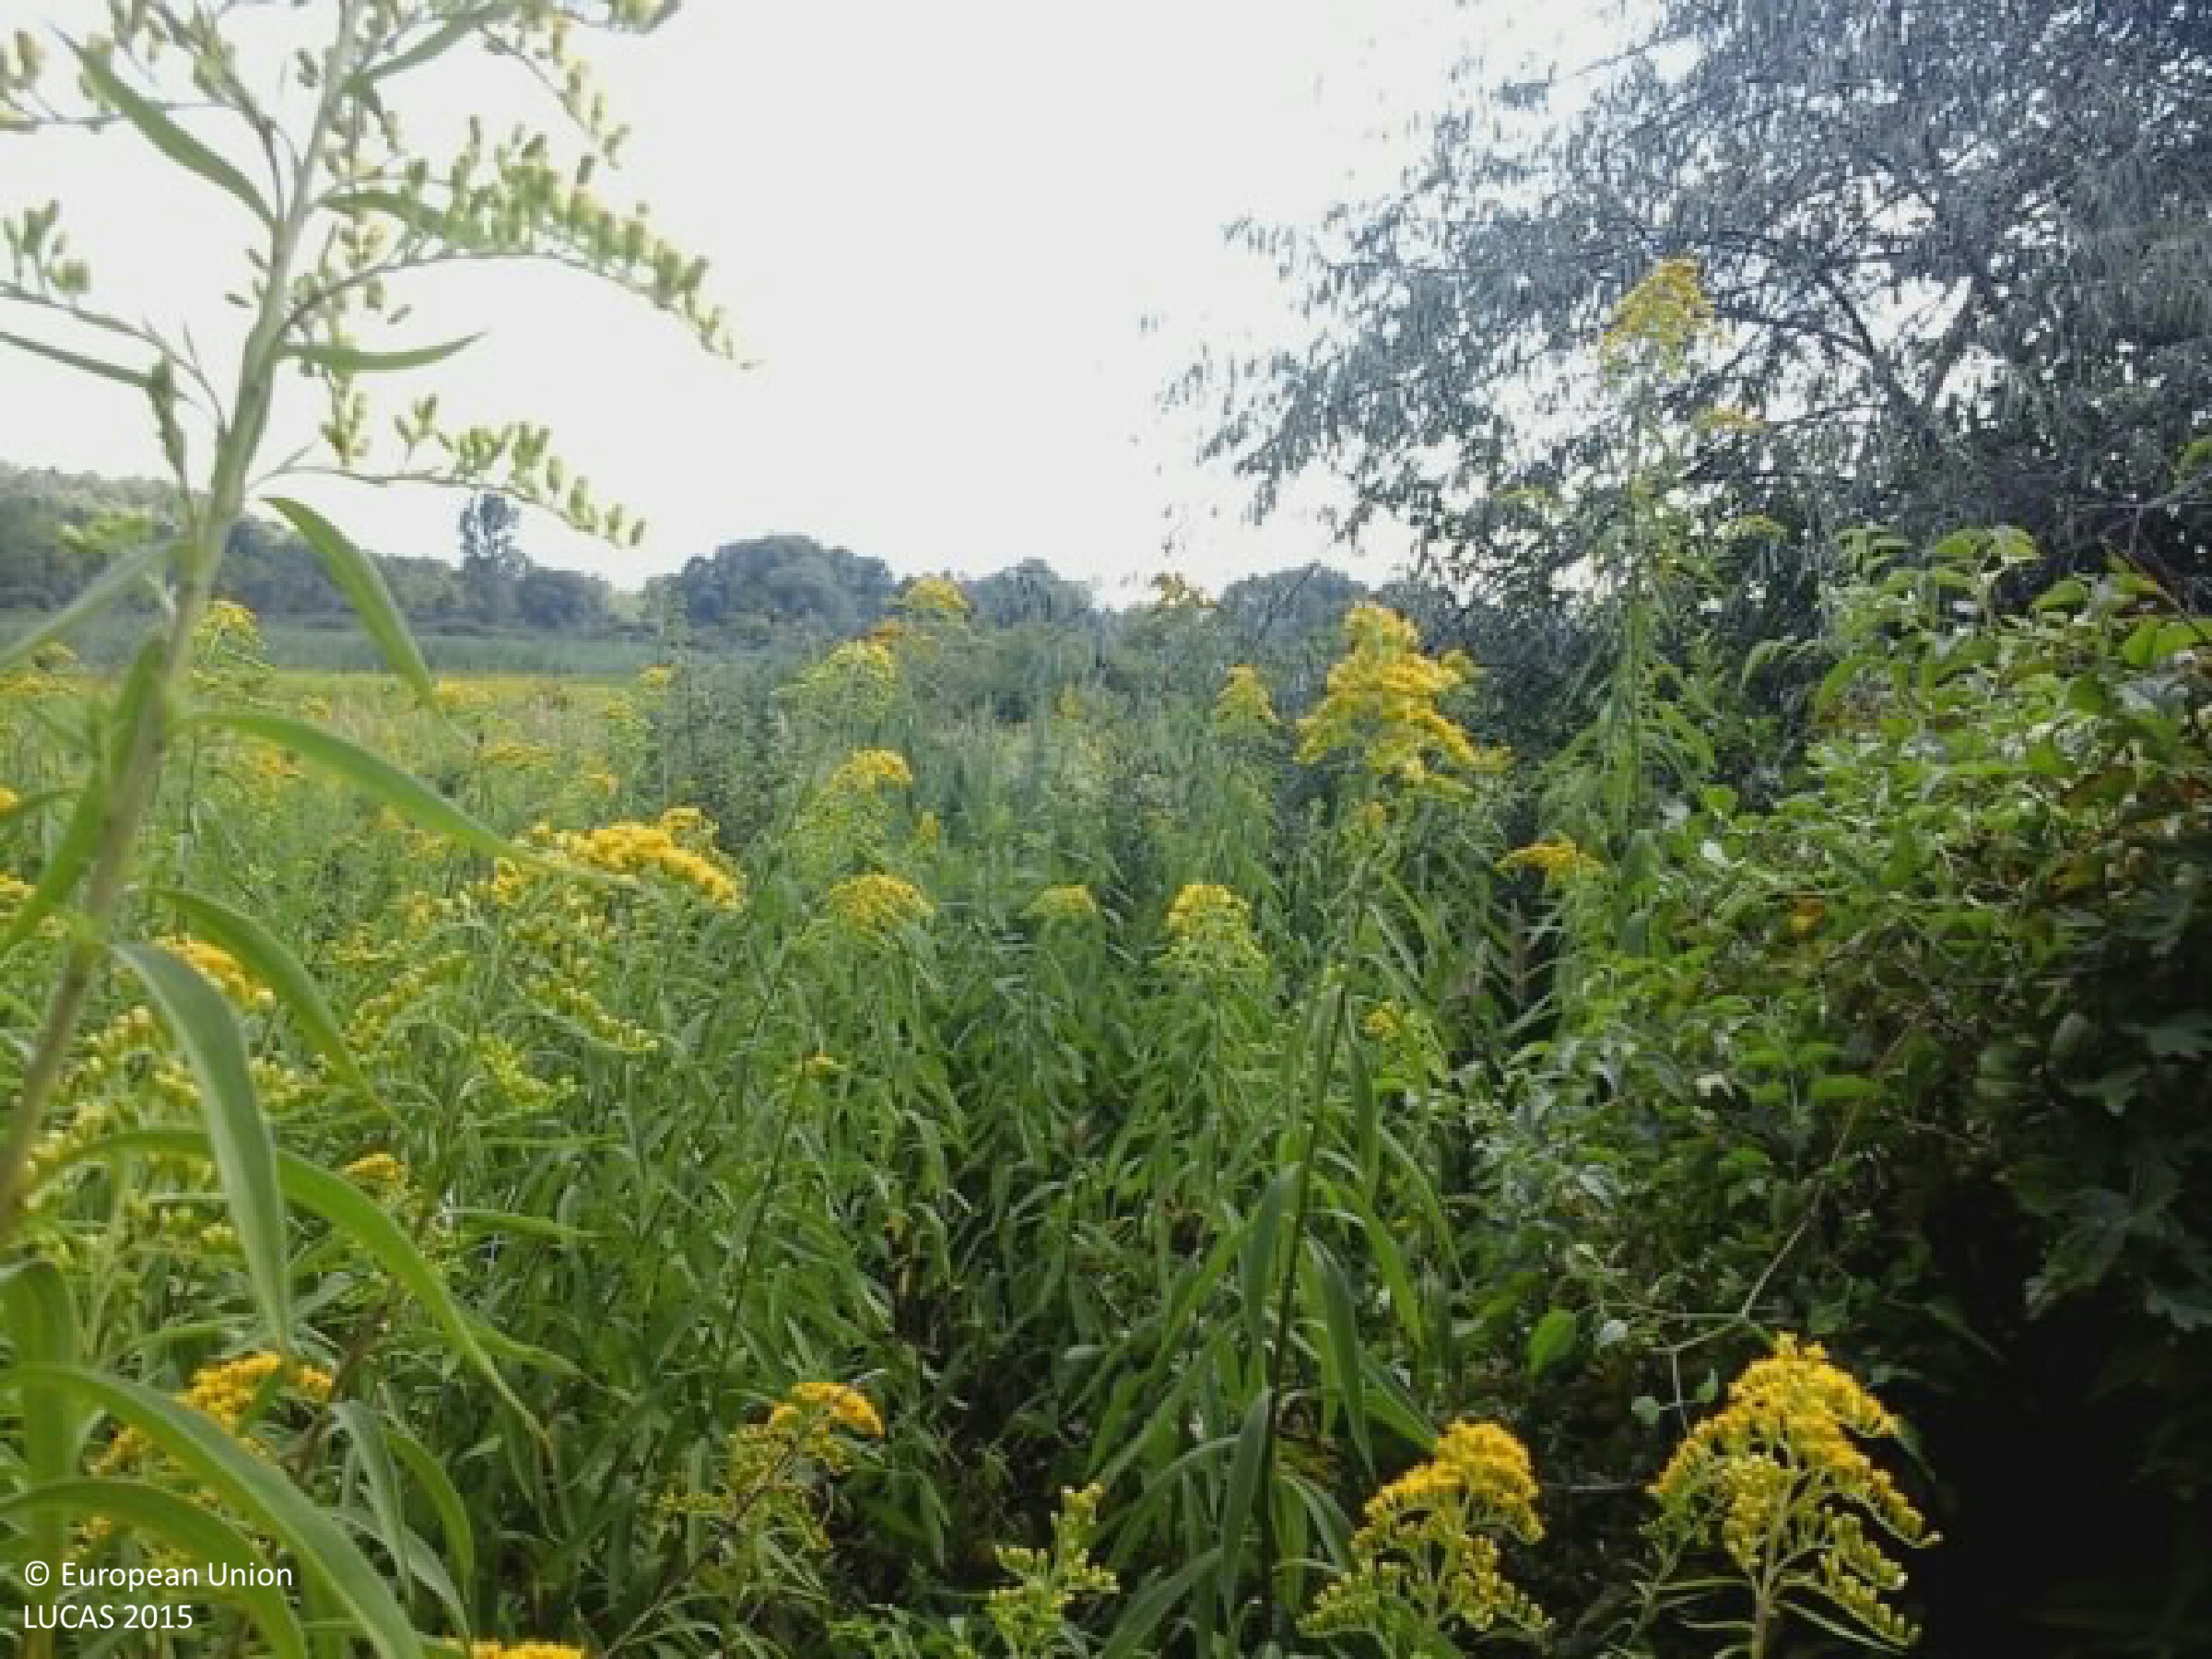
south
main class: Grassland
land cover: Spontaneously vegetated surfaces
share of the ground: > 75 %
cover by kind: herbaceous plants 95 %, shrubs 5 %
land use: Fallow land
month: August
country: HU
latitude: 46.8061
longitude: 18.3050
